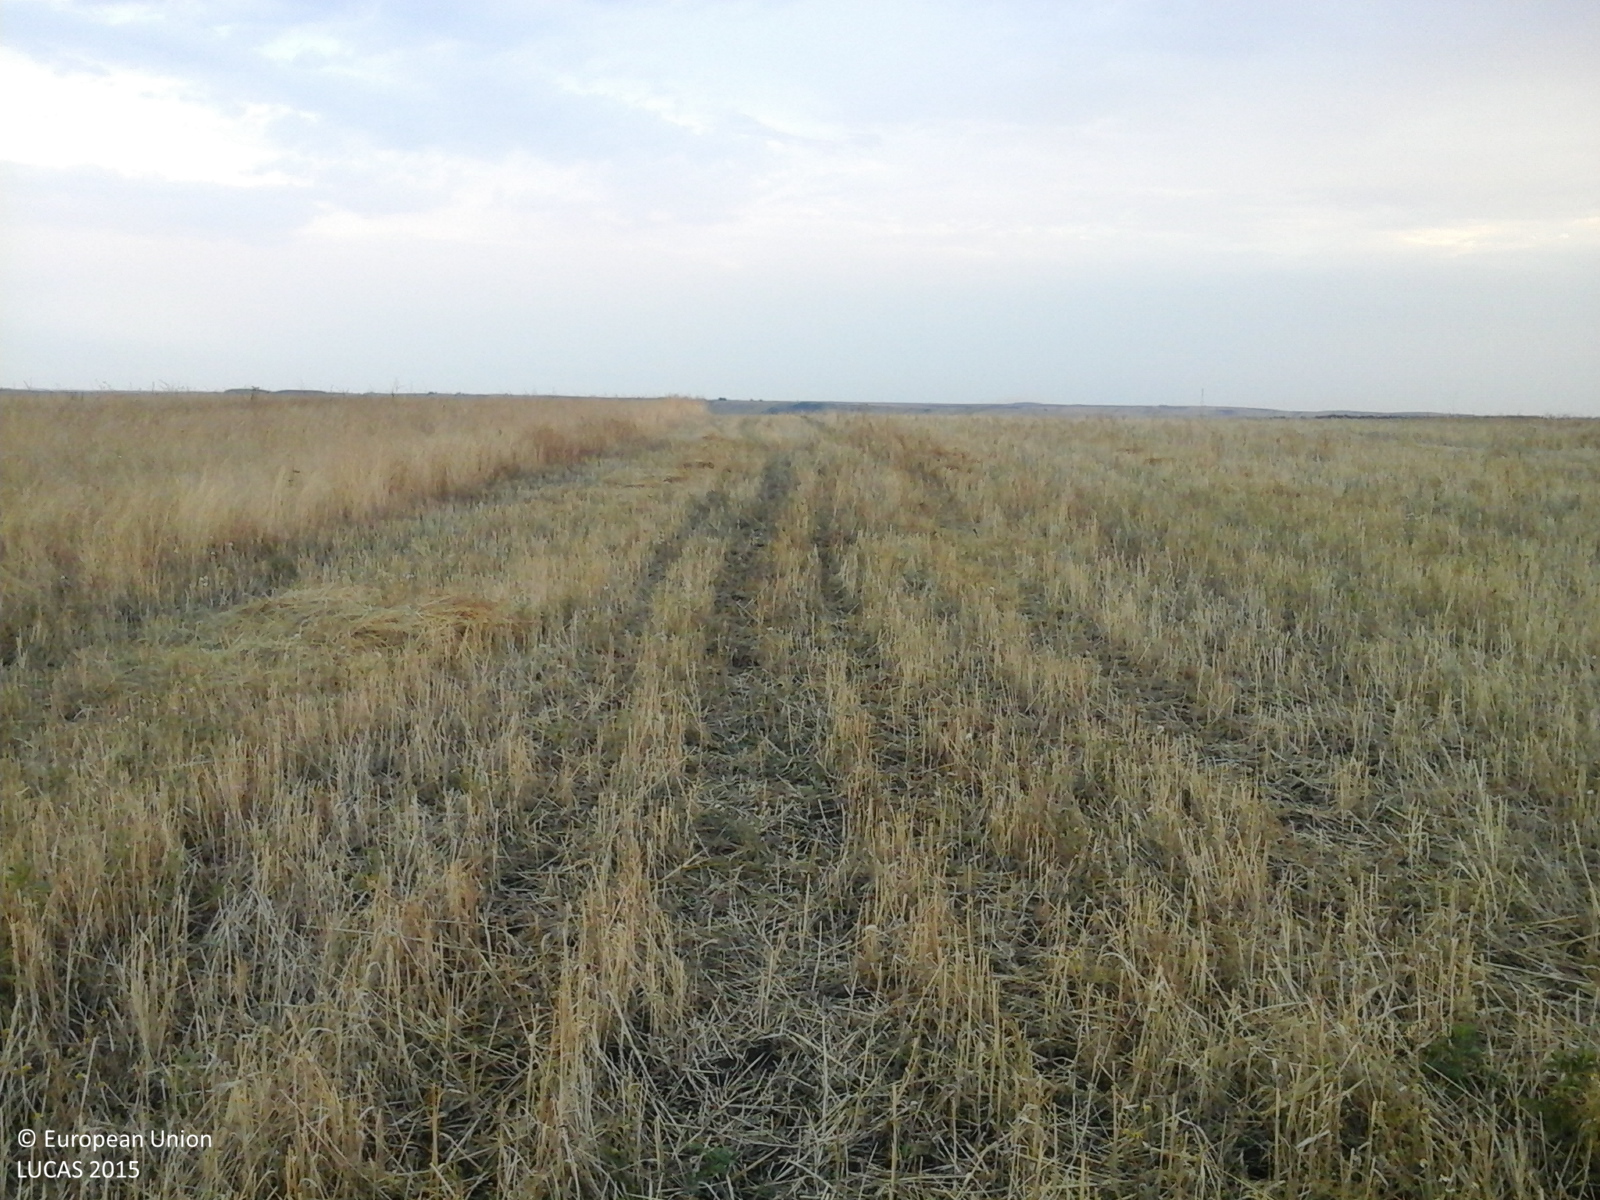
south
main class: Cropland
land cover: Mixed cereals for fodder
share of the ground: > 75 %
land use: Agriculture (excluding fallow land and kitchen gardens)
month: August
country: RO
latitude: 44.5332
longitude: 22.9947
